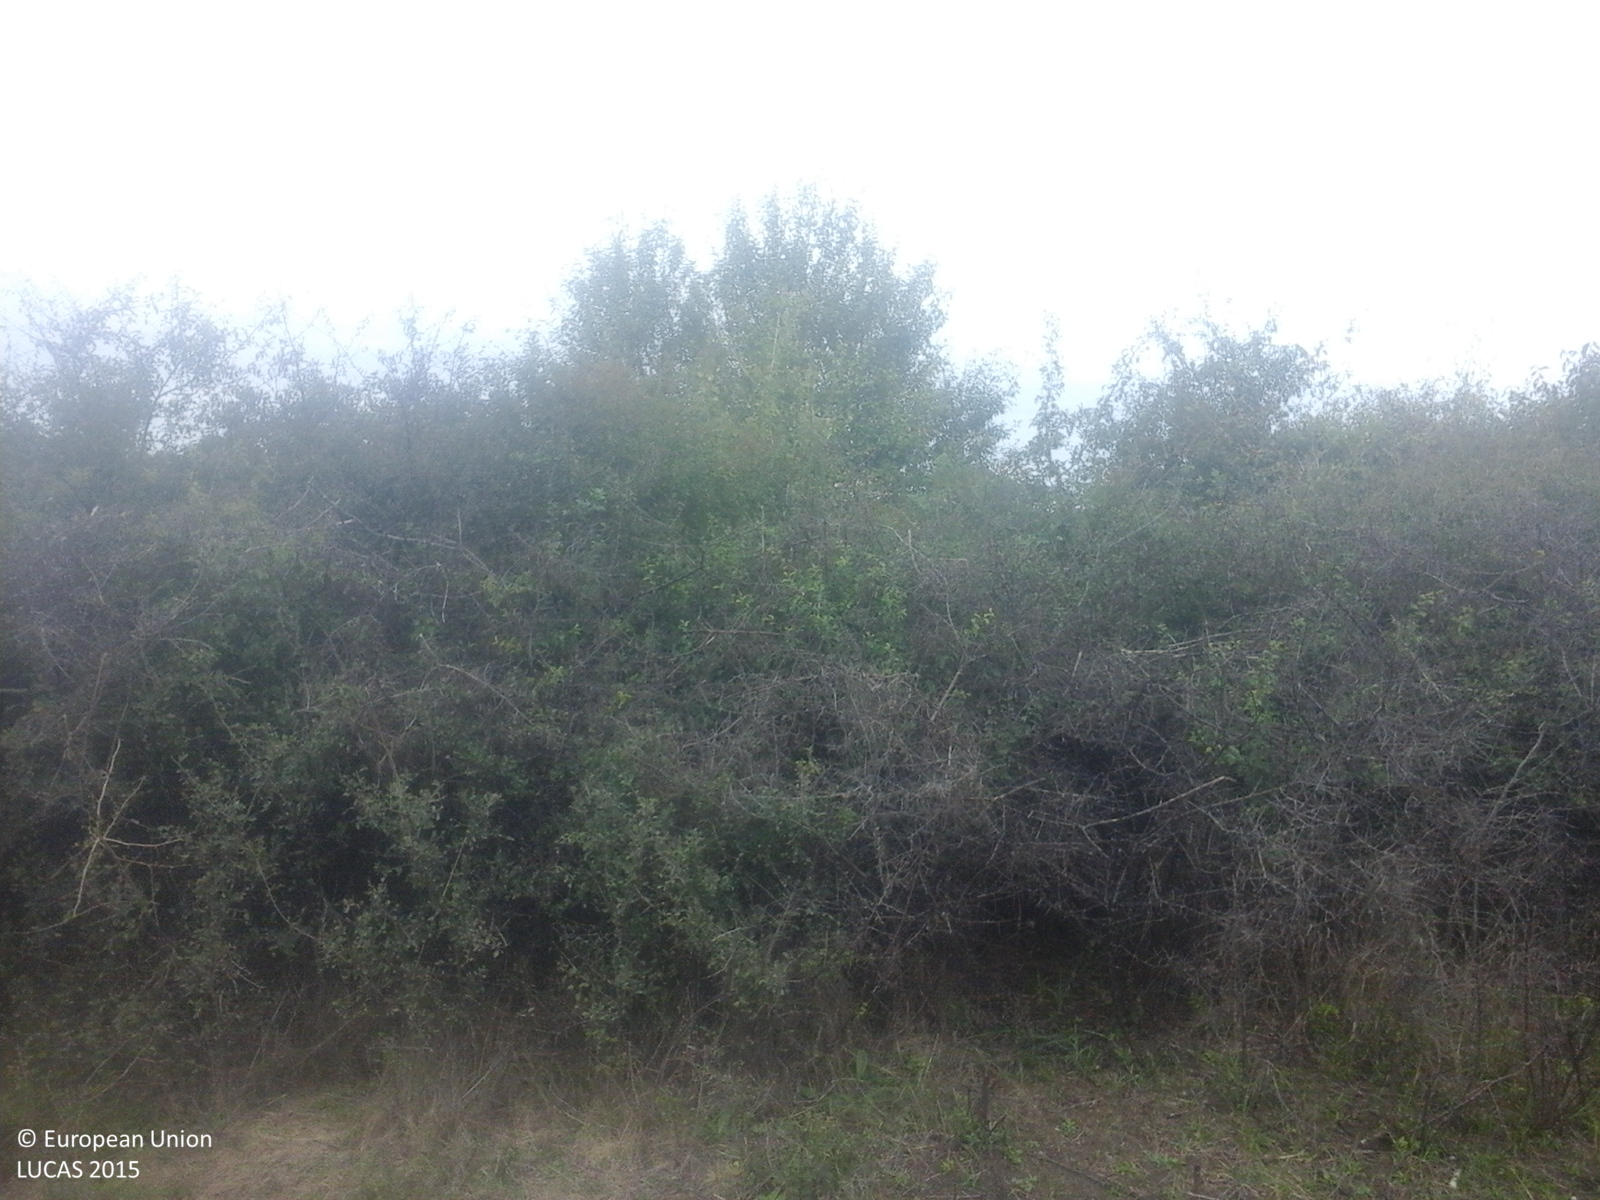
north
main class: Shrubland
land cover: Shrubland with sparse tree cover
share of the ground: > 75 %
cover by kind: shrubs 85 %, herbaceous plants 10 %, broadleaved forest trees 5 %
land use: Fallow land
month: September
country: RO
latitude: 45.9479
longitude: 23.9136
